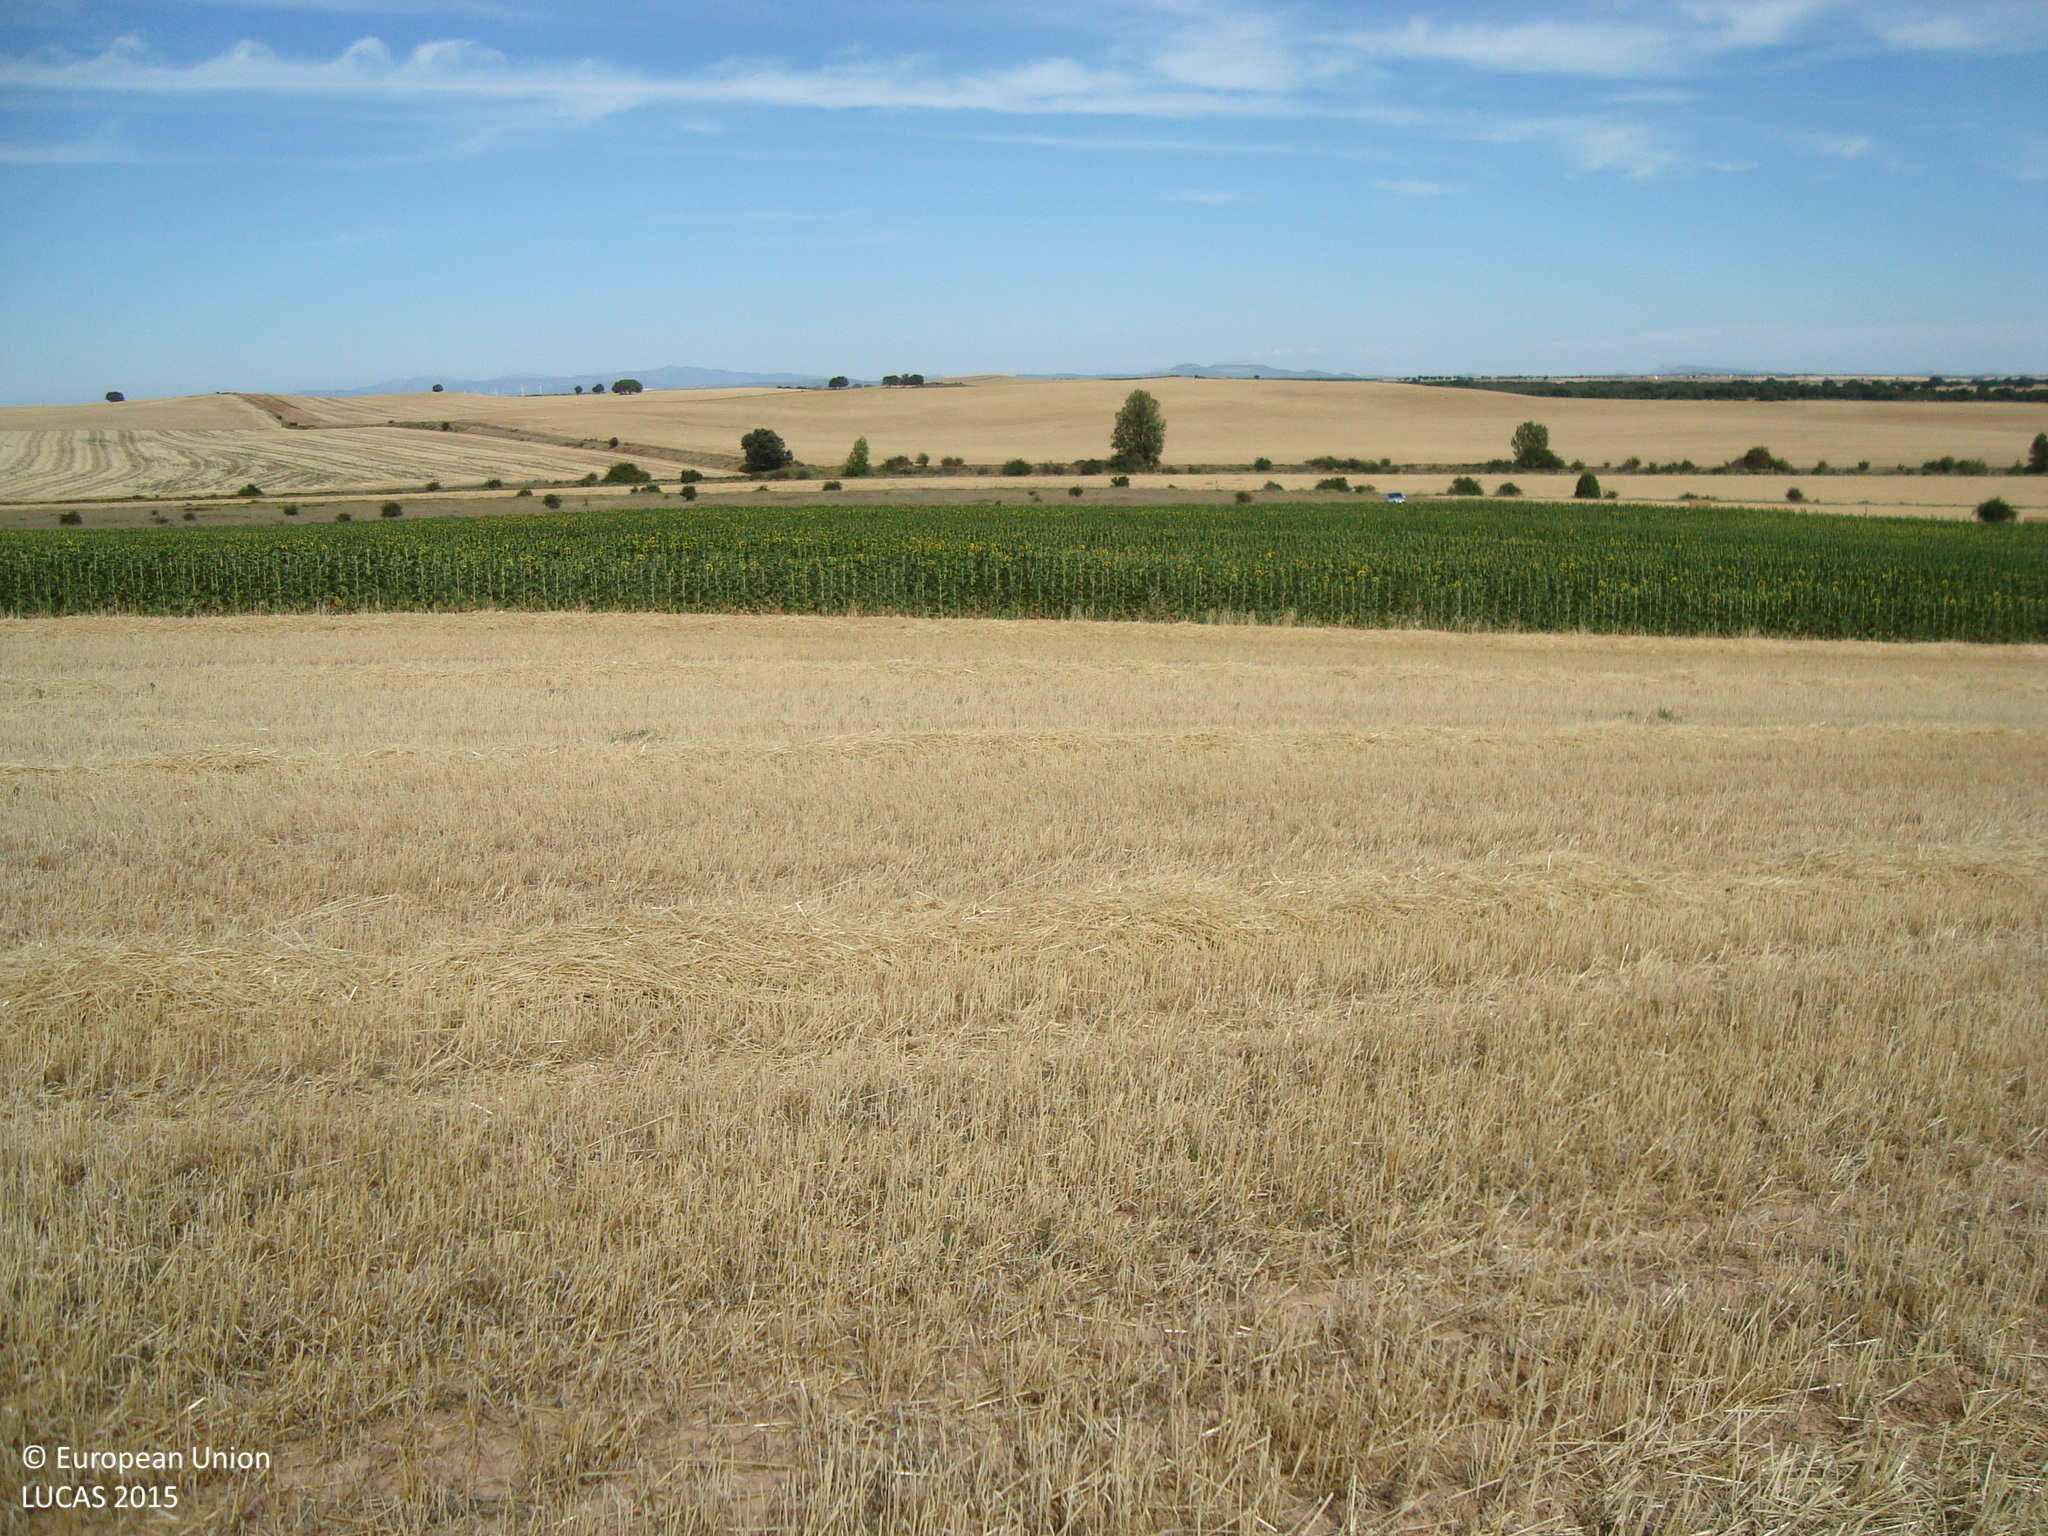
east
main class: Cropland
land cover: Barley
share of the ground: > 75 %
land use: Agriculture (excluding fallow land and kitchen gardens)
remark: Harvested field
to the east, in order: Barley; Sunflower; Grassland without tree/shrub cover
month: July
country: ES
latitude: 42.1344
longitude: -3.8649
